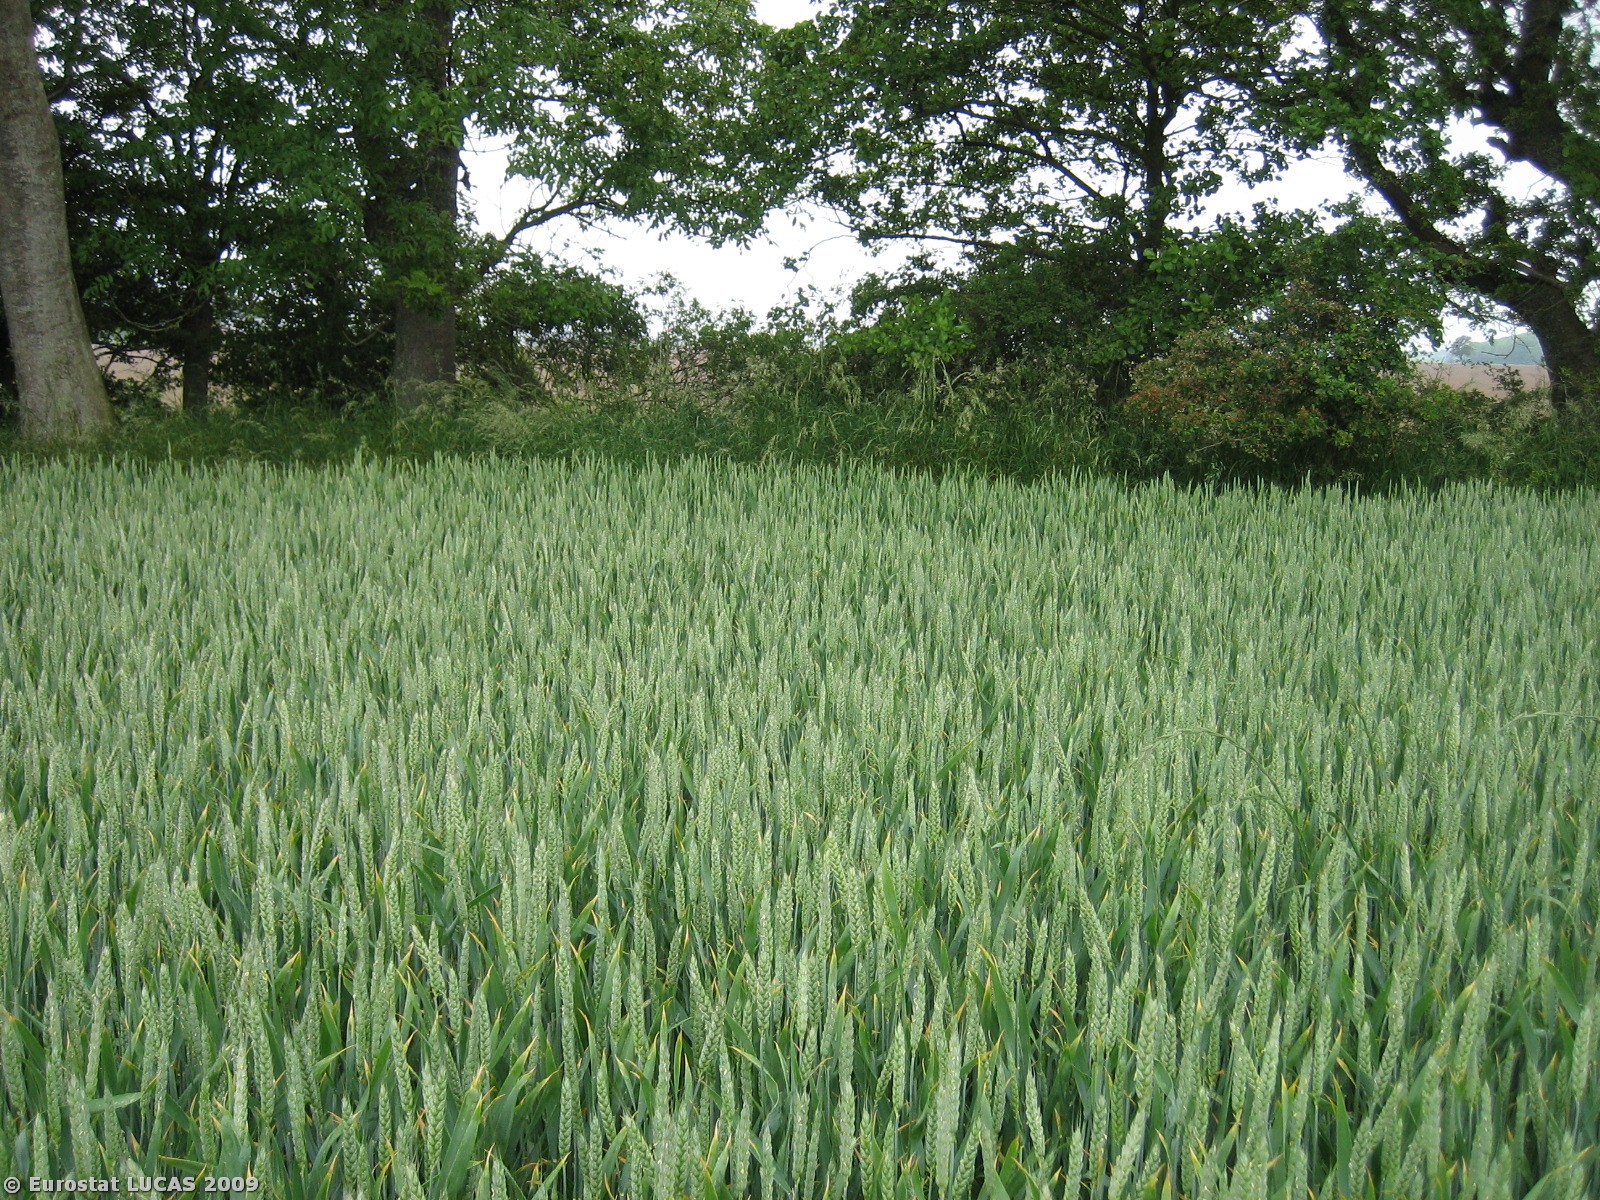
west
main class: Cropland
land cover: Common wheat
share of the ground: > 75 %
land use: Agriculture (excluding fallow land and kitchen gardens)
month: June
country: DK
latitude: 55.8641
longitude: 10.1756
